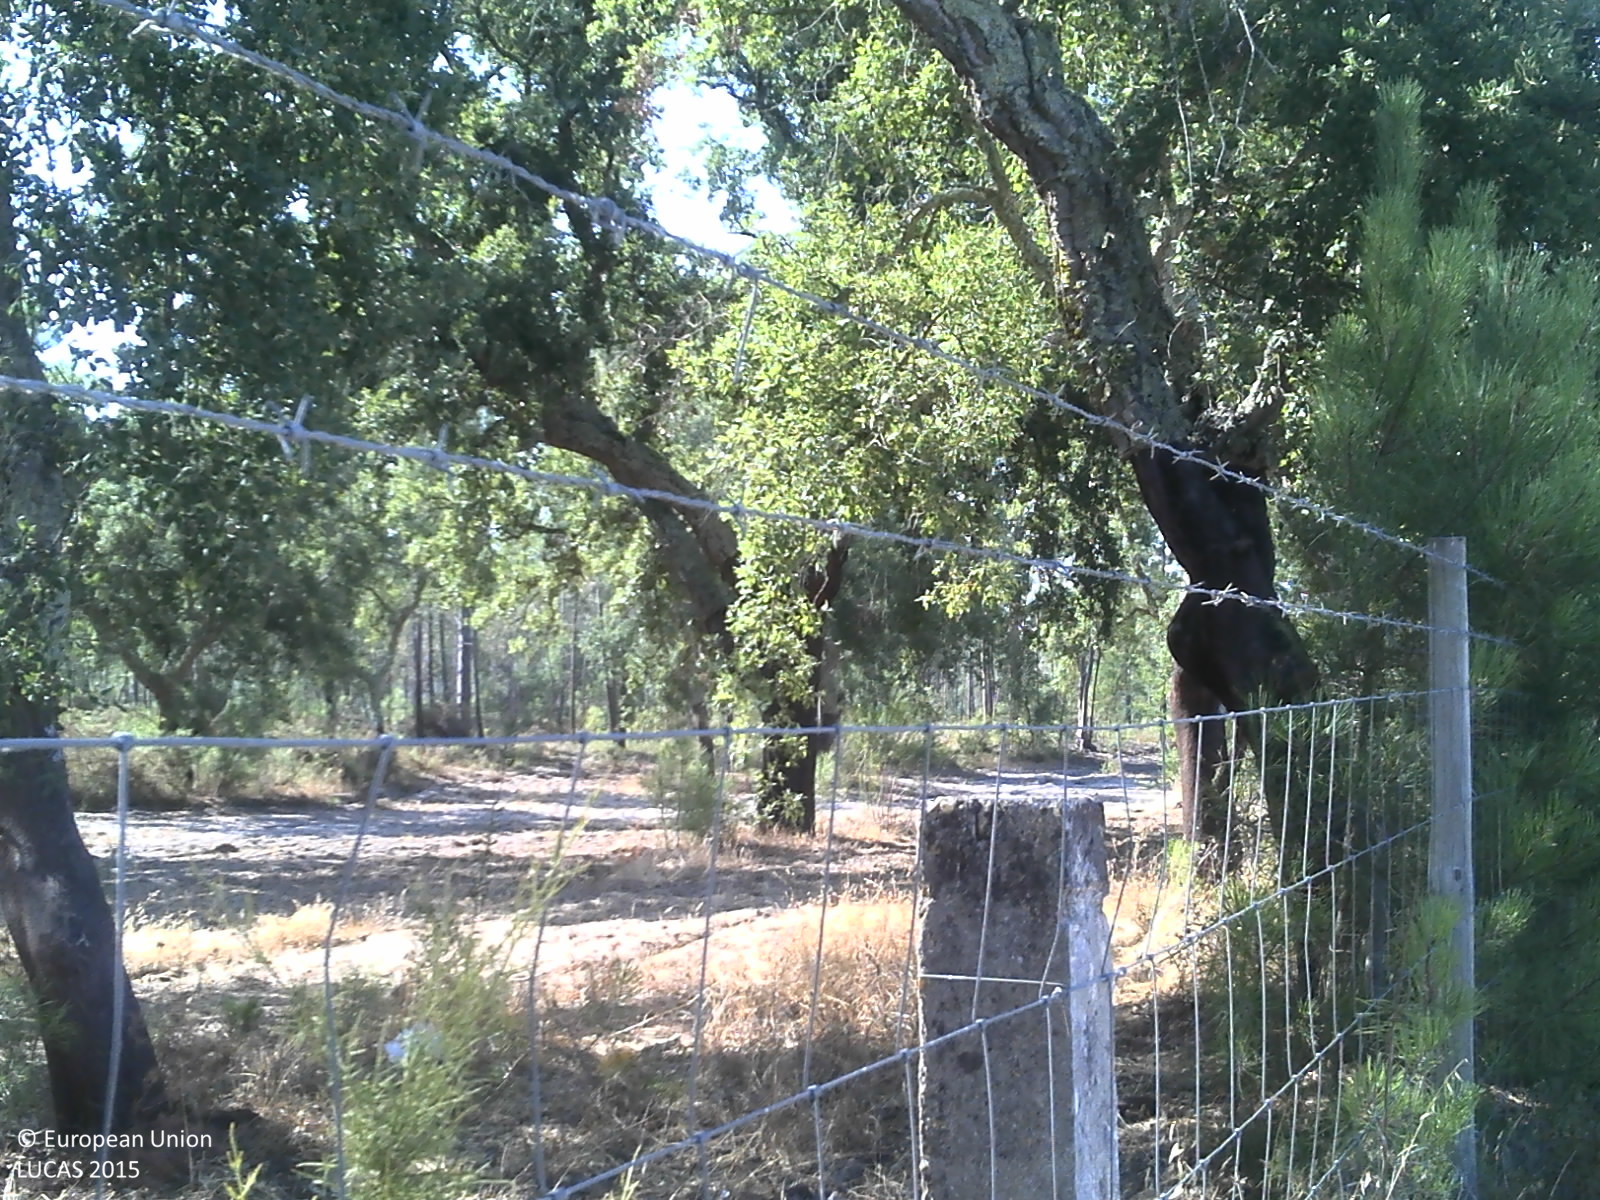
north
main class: Woodland
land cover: Pine dominated coniferous woodland
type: coniferous forest of the mediterranean region
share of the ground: 50 - 75 %
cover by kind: coniferous forest trees 65 %, unconsolidated bare surface 15 %, shrubs 10 %, broadleaved forest trees 5 %, herbaceous plants 5 %
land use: Forestry
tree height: > 5 m
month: July
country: PT
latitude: 38.9682
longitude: -8.6126
